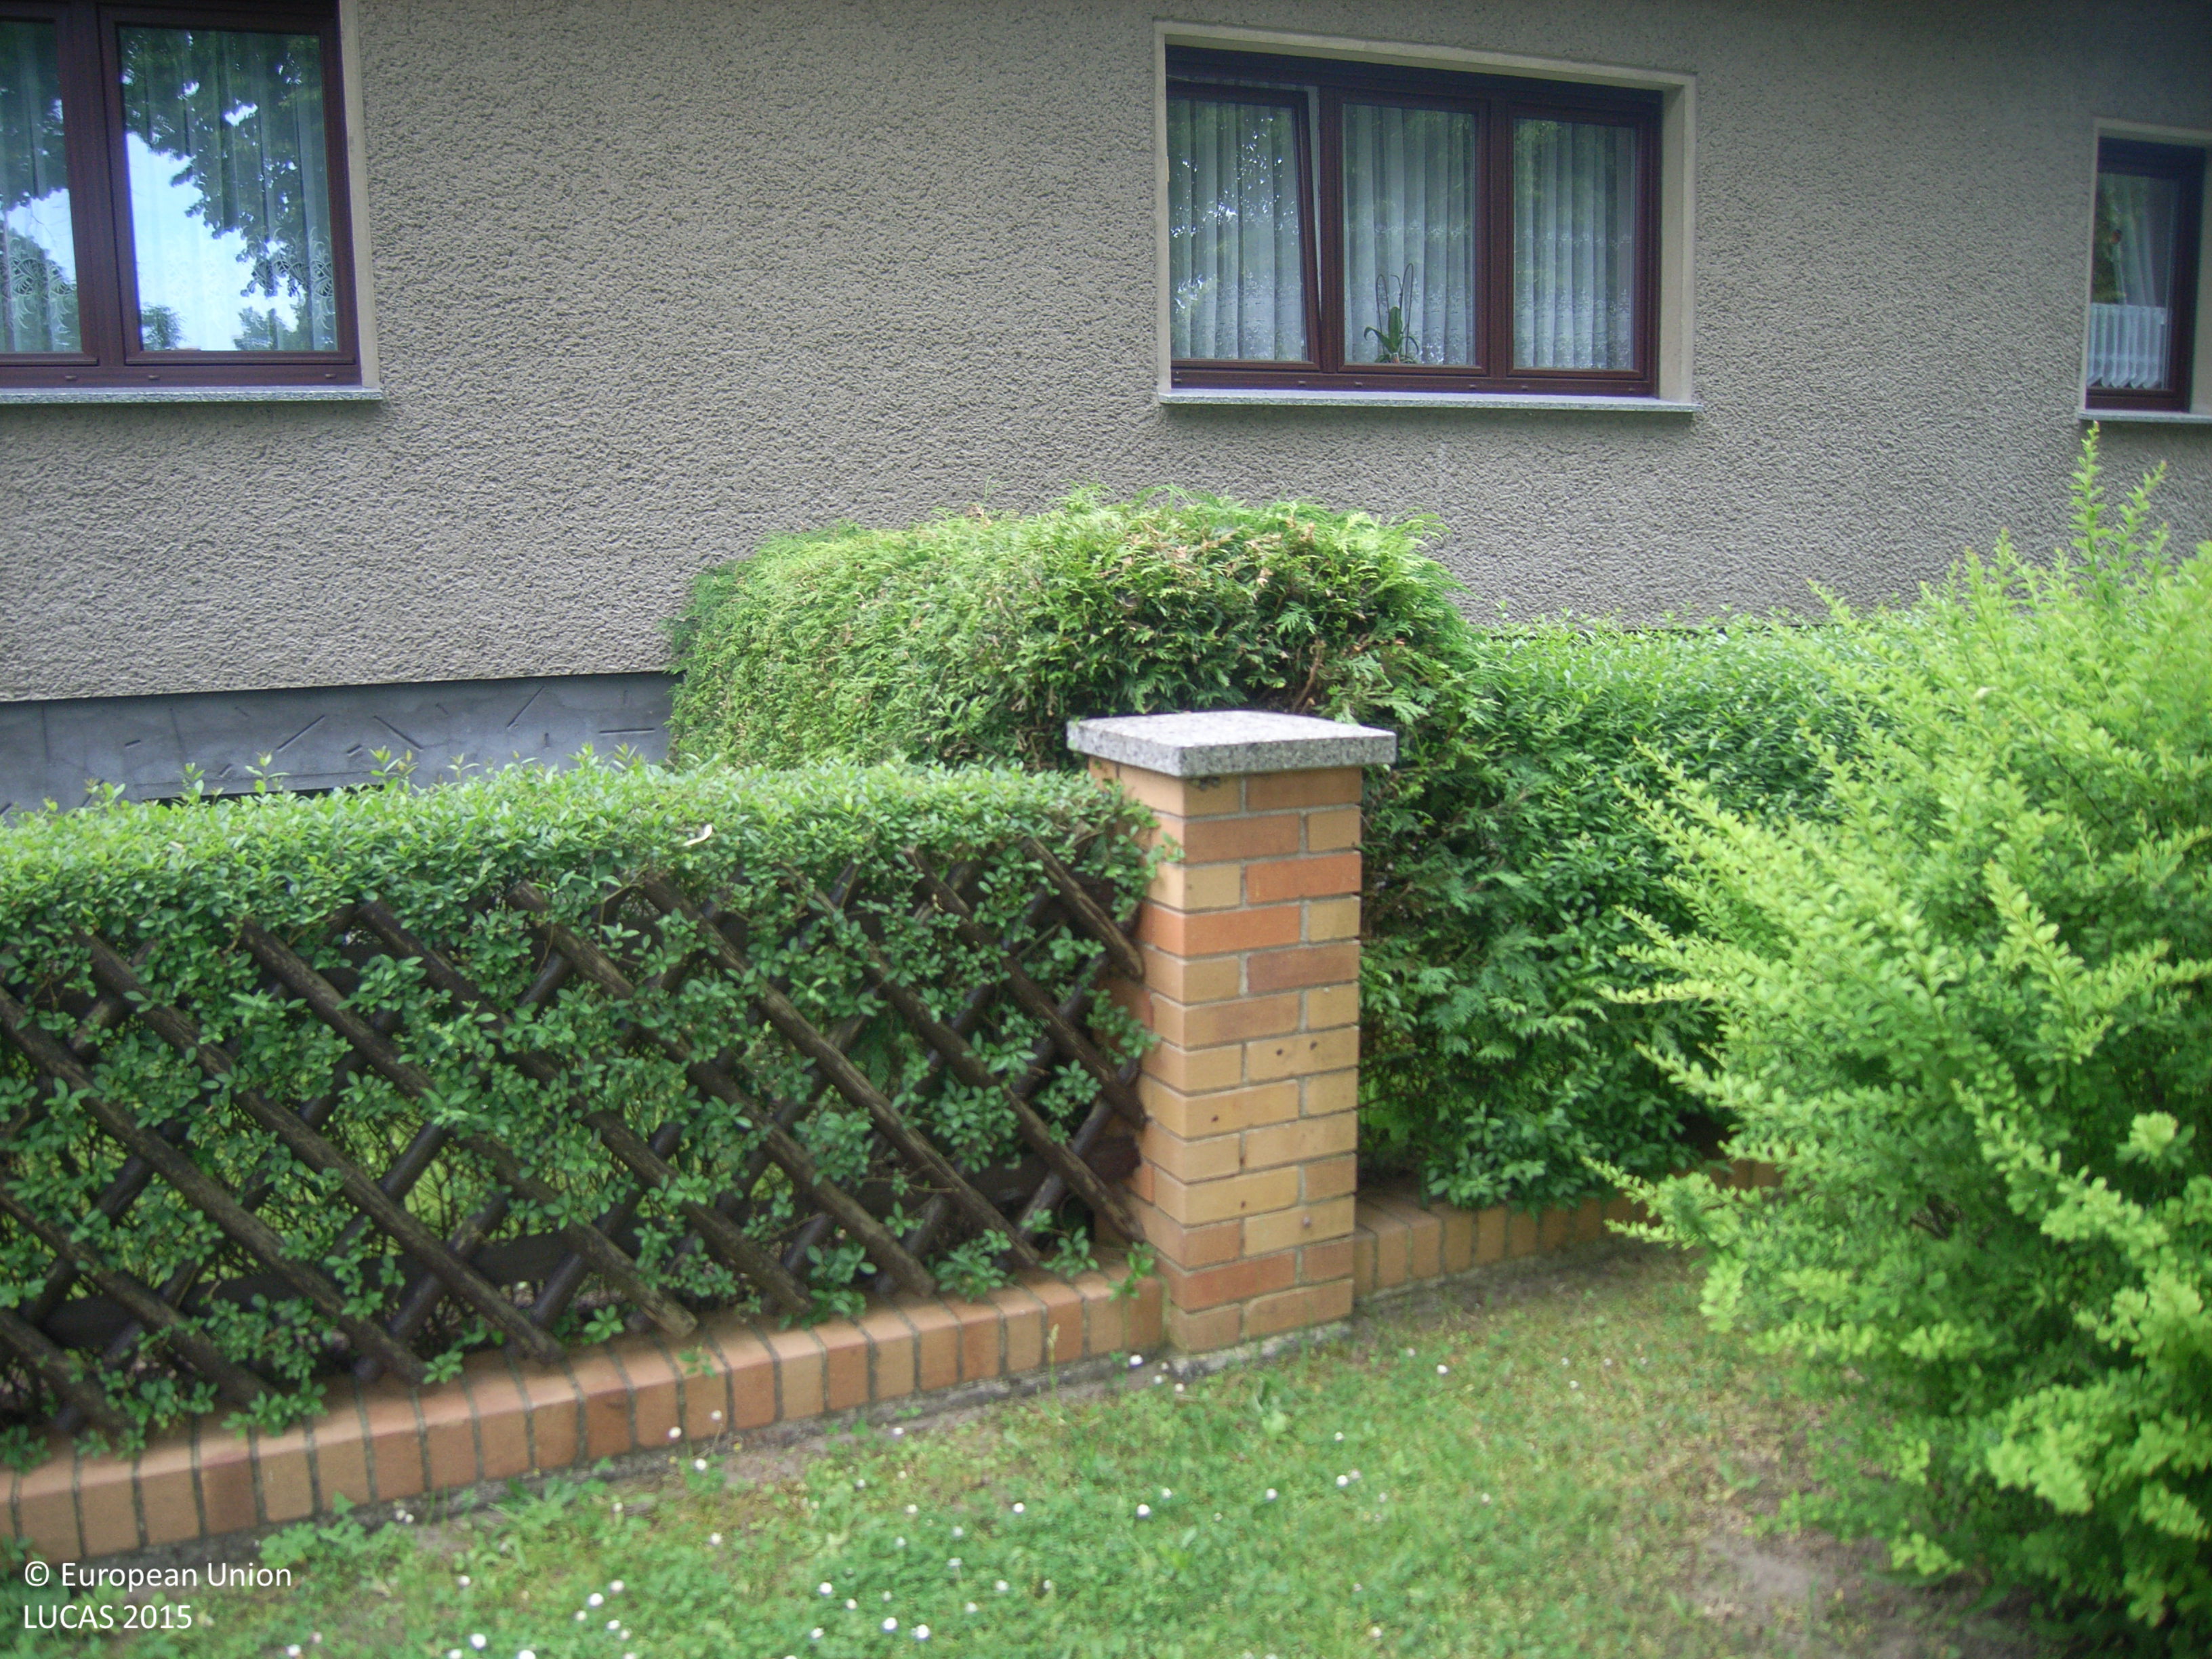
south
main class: Grassland
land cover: Grassland with sparse tree/shrub cover
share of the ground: > 75 %
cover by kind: herbaceous plants 95 %, broadleaved forest trees 5 %
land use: Road transport
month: June
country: DE
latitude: 52.1983
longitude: 14.1122
